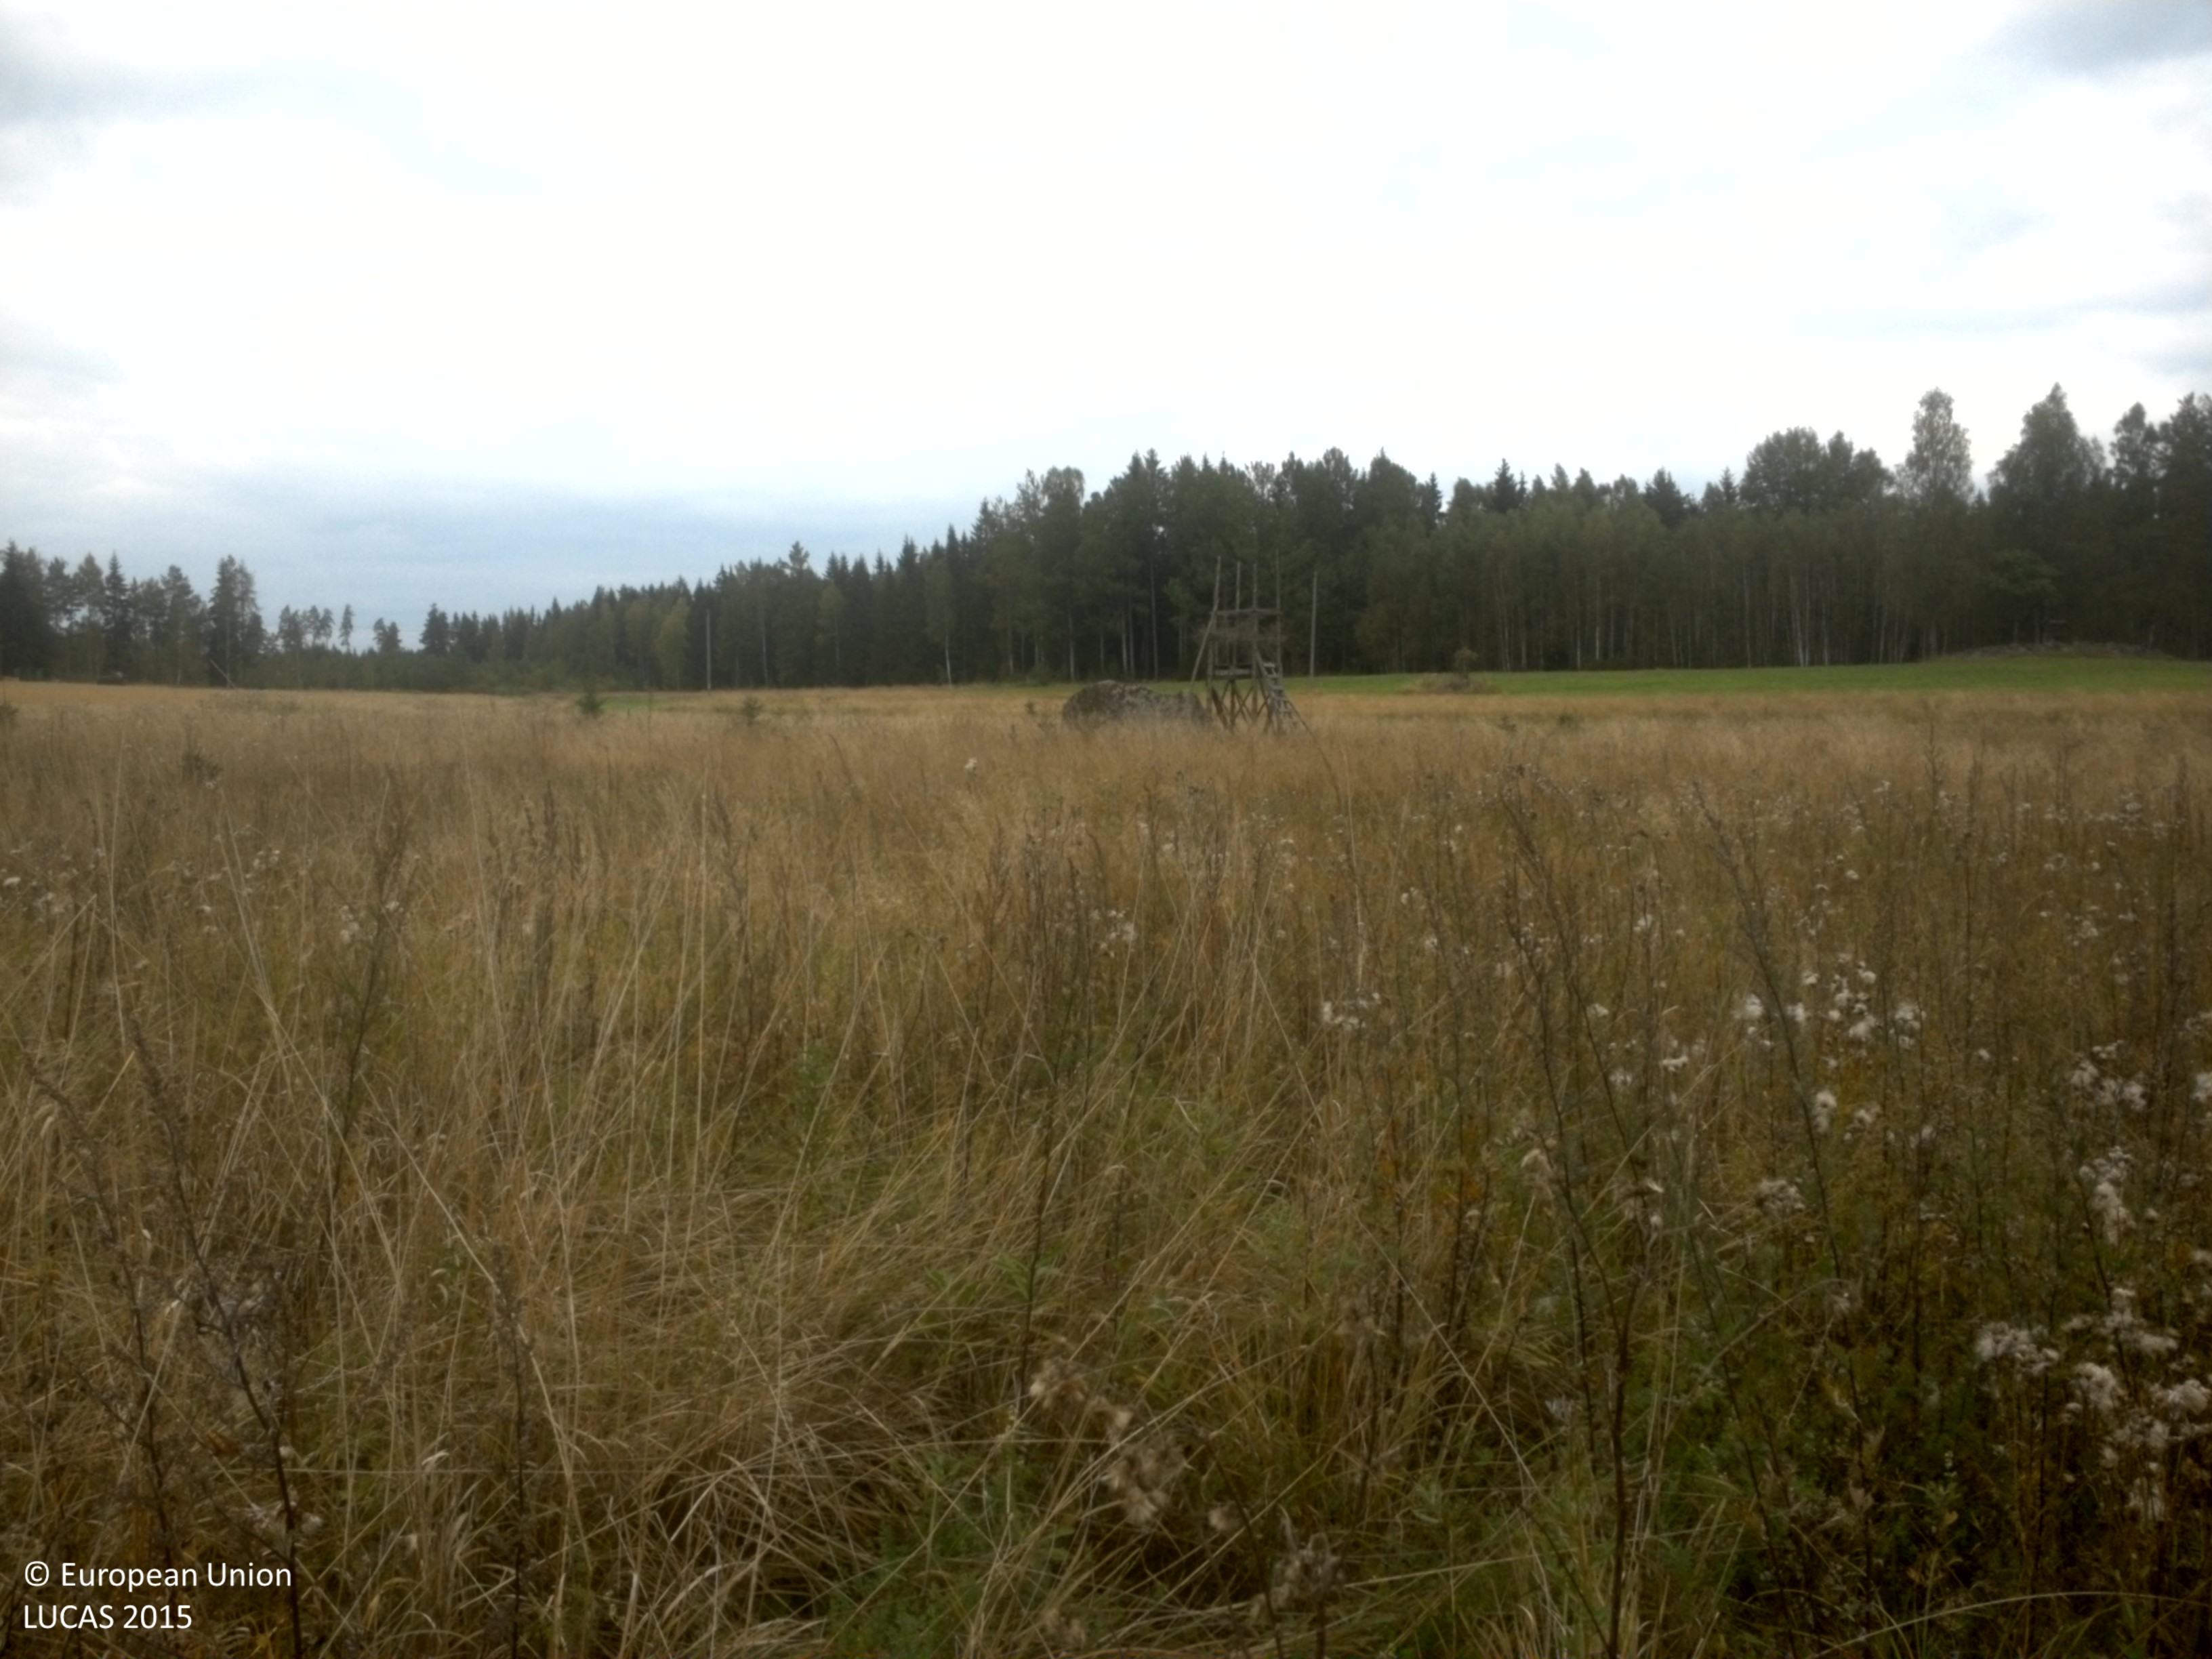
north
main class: Grassland
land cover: Spontaneously vegetated surfaces
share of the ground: > 75 %
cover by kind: herbaceous plants 100 %
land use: Agriculture (excluding fallow land and kitchen gardens)
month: September
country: SE
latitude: 59.5697
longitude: 15.4604
